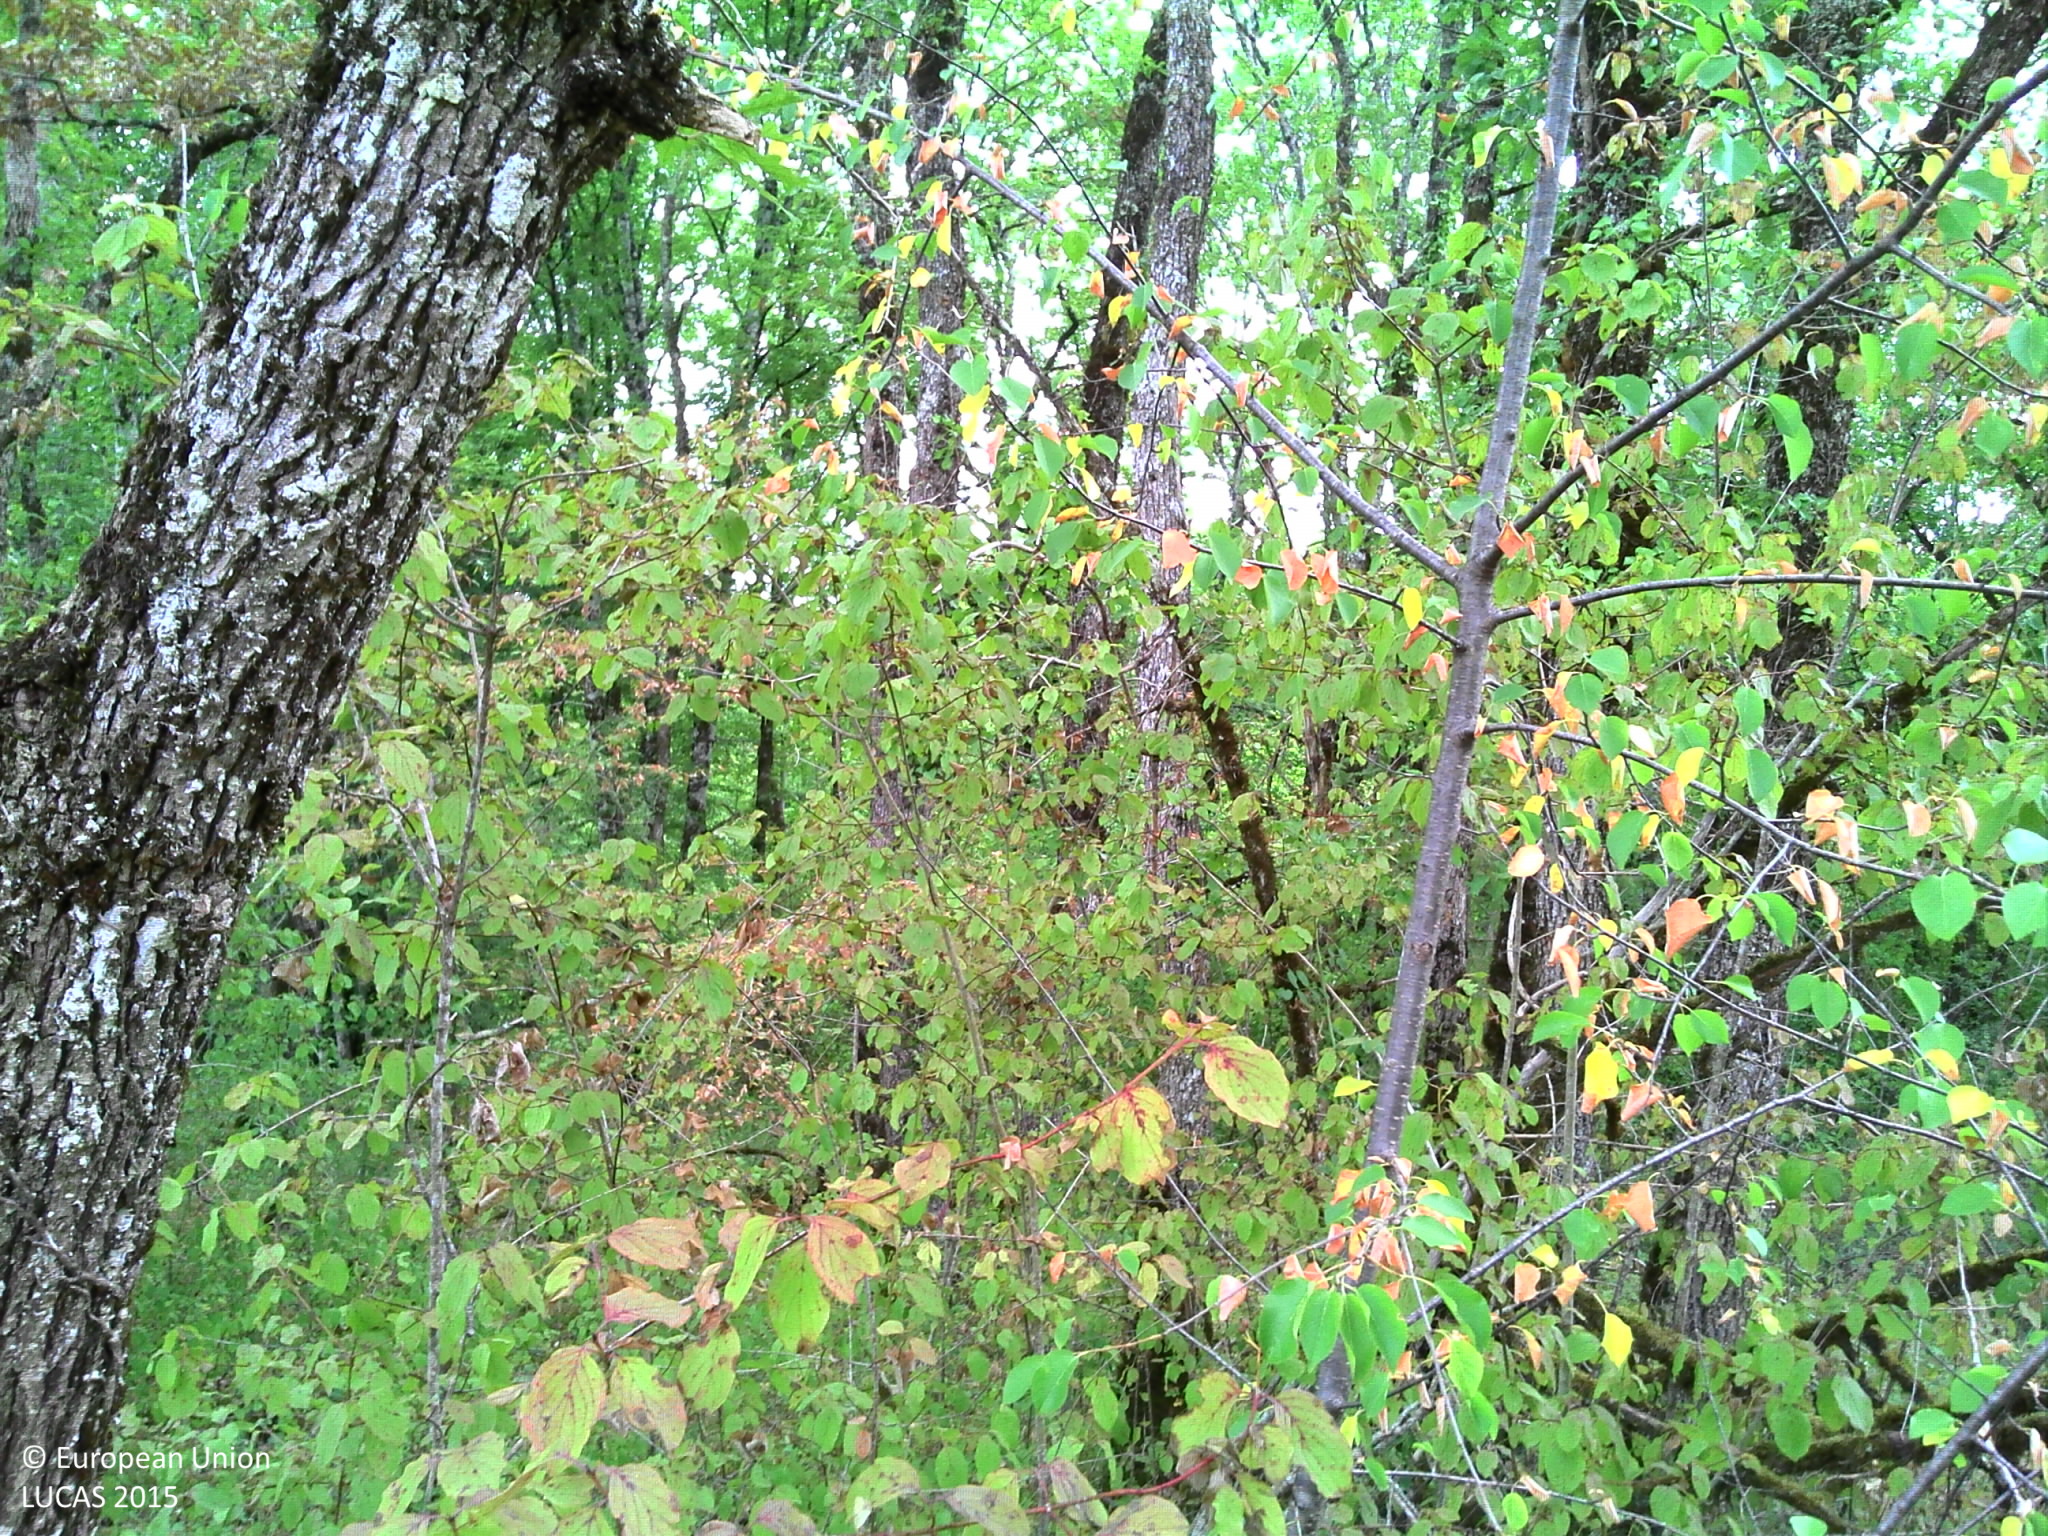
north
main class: Woodland
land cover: Broadleaved woodland
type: acidophilous oak and oak-birch forest
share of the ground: > 75 %
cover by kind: broadleaved forest trees 65 %, herbaceous plants 25 %, coniferous forest trees 5 %, shrubs 5 %
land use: Forestry
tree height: > 5 m
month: July
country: FR
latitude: 45.0106
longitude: 1.4309
